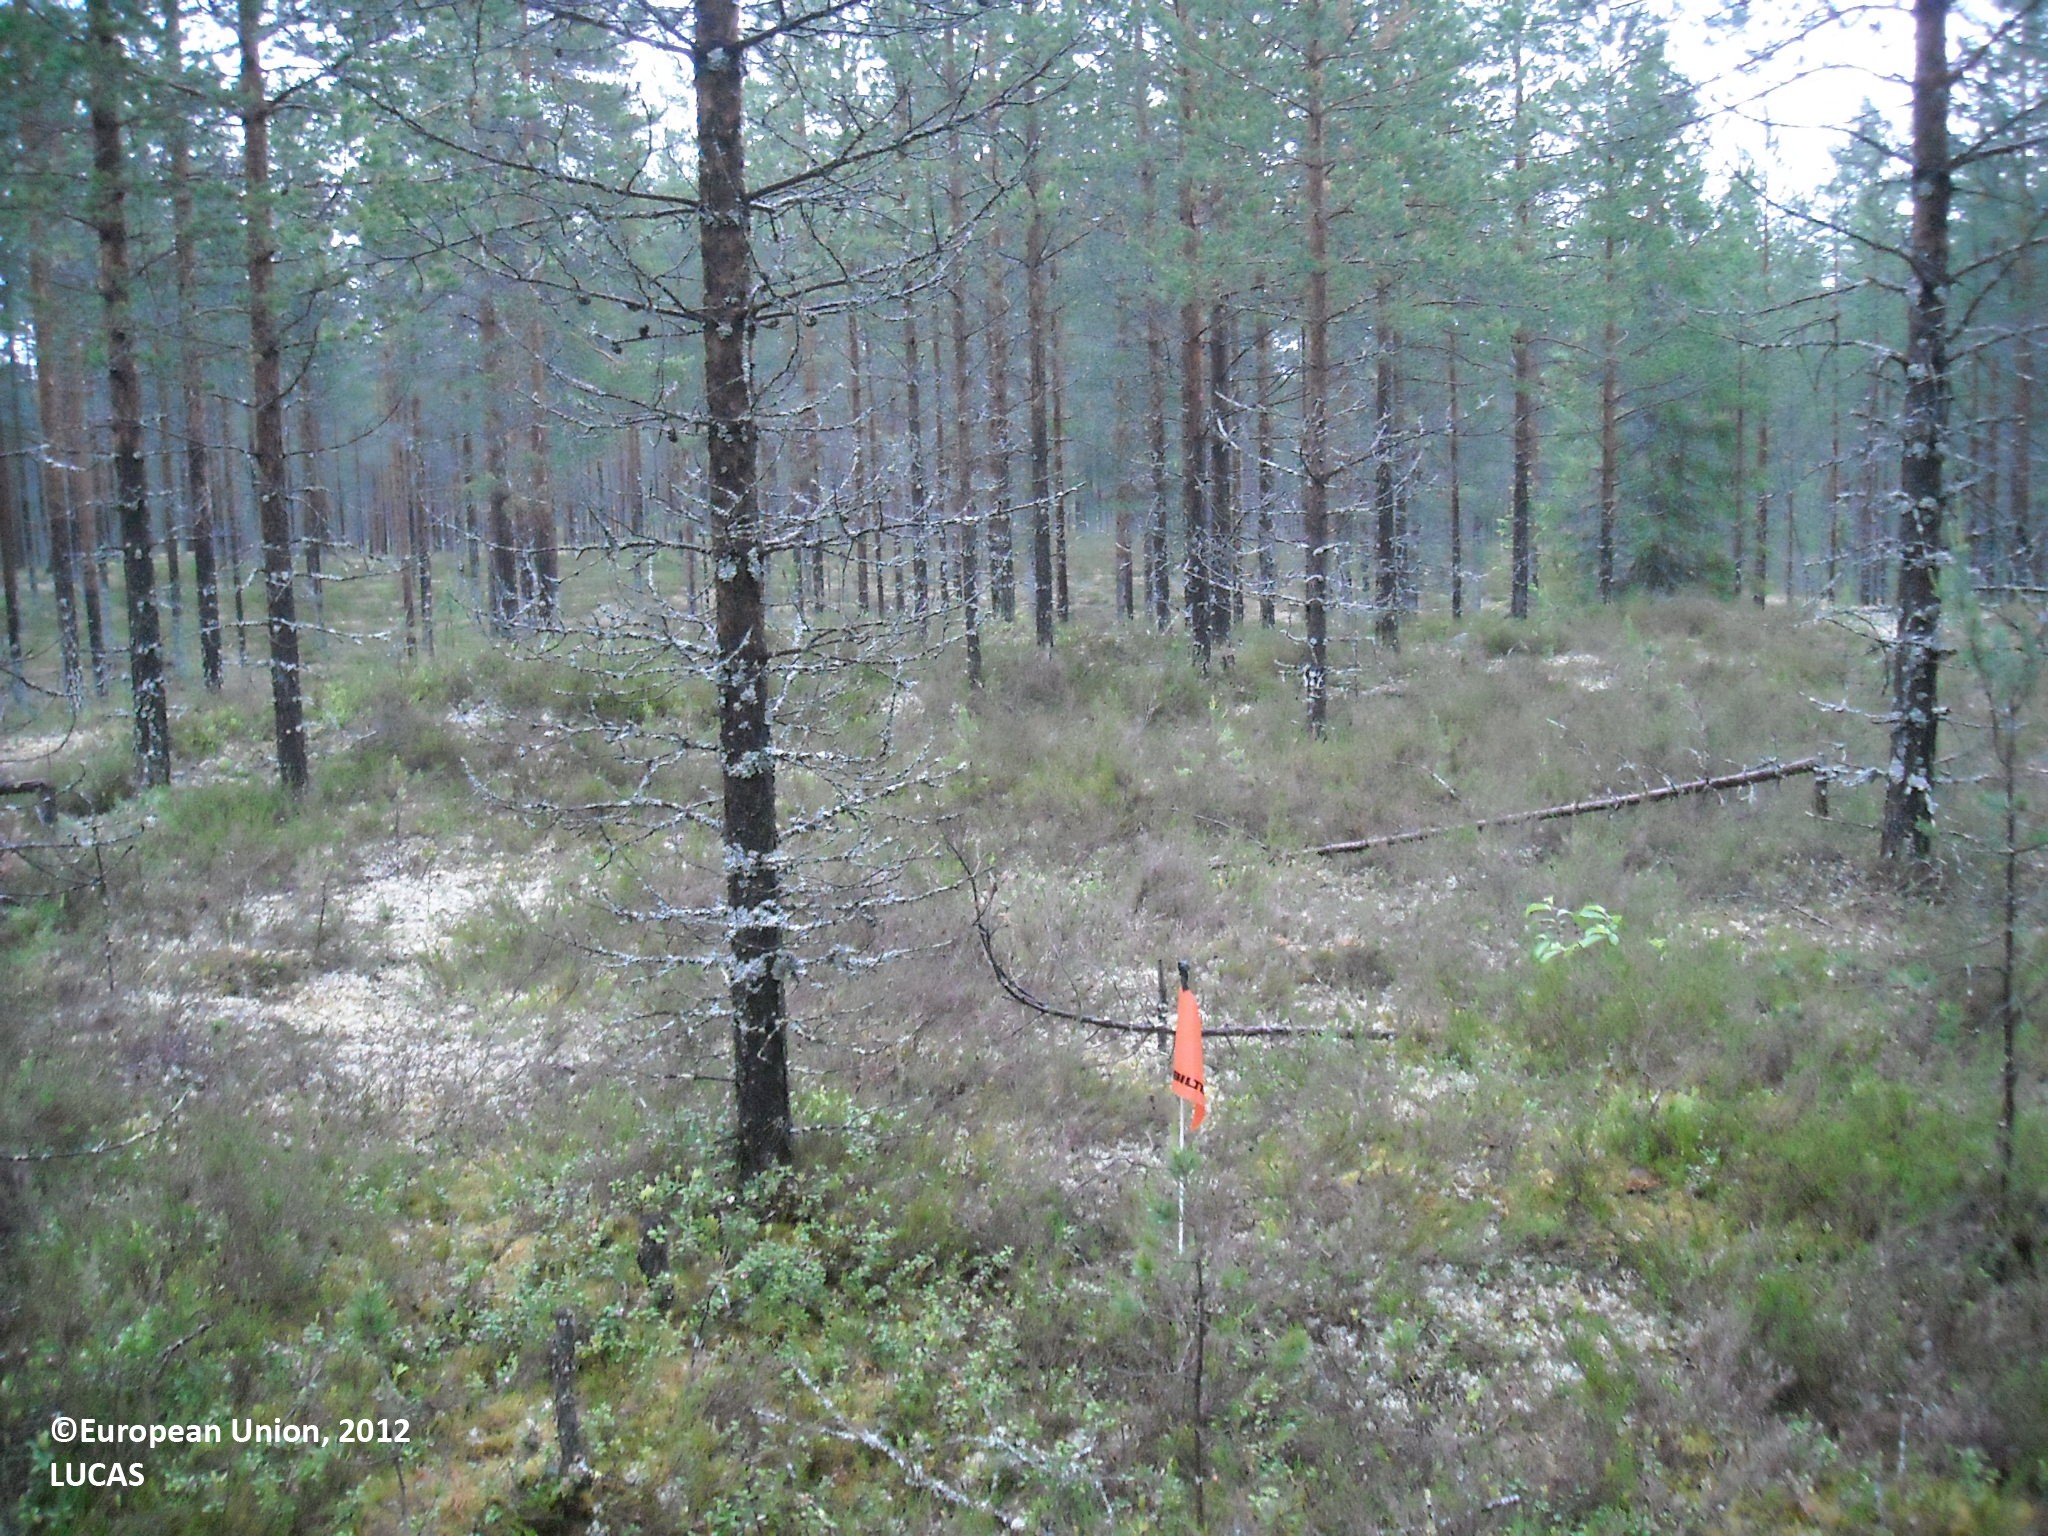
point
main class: Woodland
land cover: Pine dominated coniferous woodland
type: boreal forest
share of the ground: 25 - 50 %
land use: Forestry
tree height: > 5 m
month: July
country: FI
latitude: 64.9883
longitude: 28.0662
